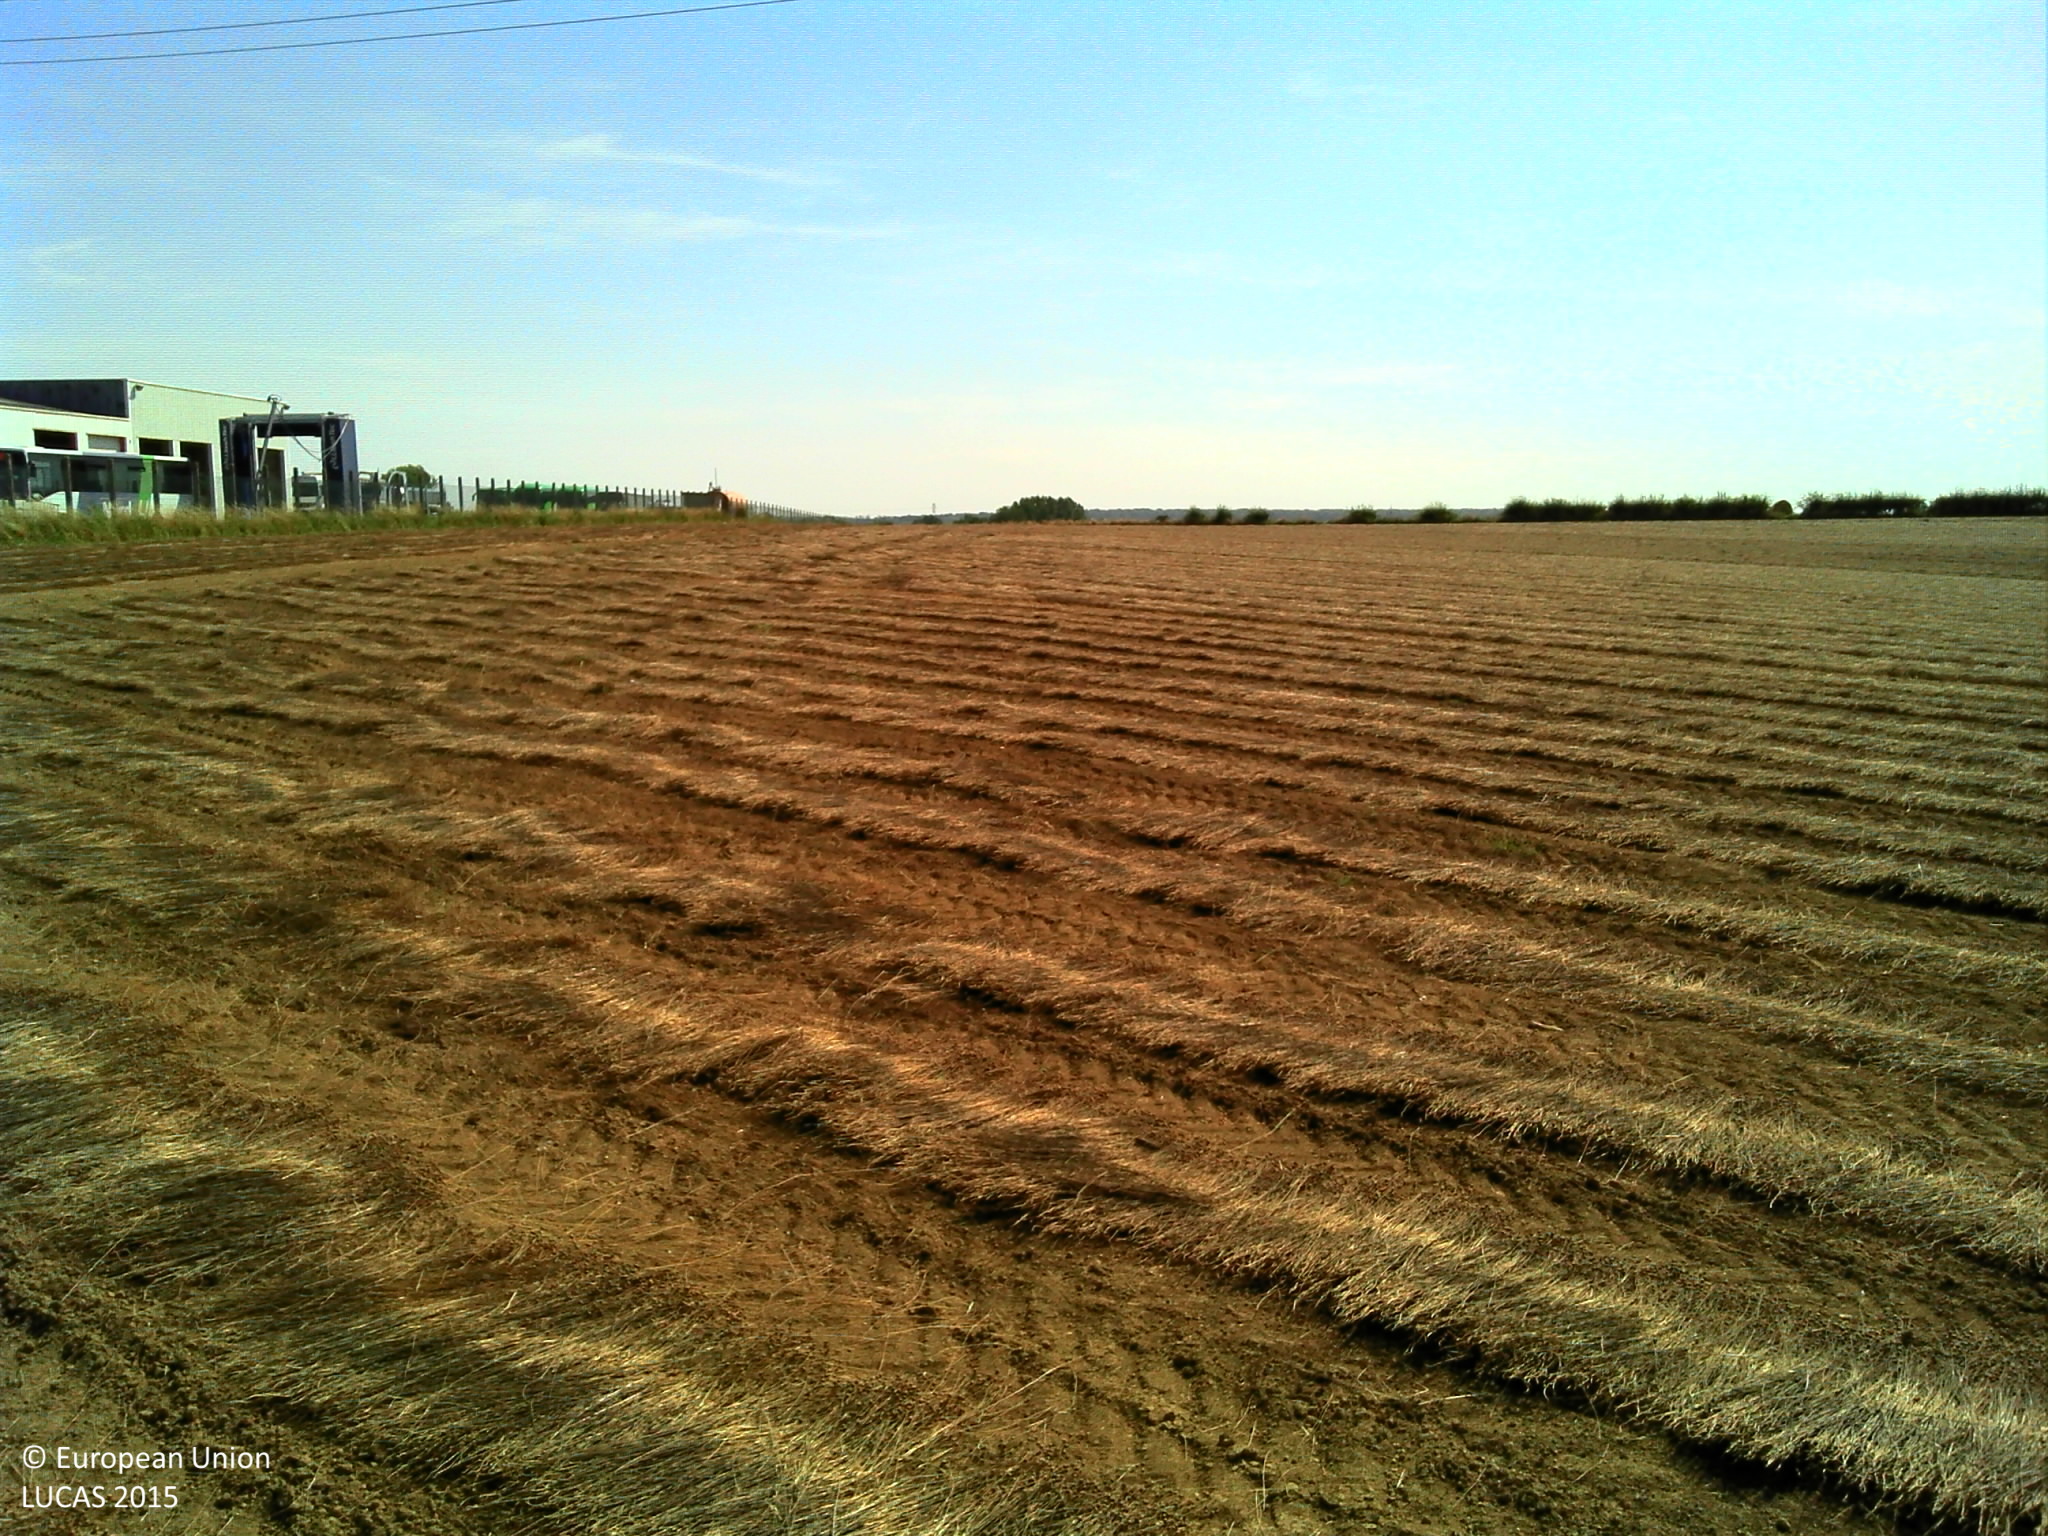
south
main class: Cropland
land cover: Other fibre and oleaginous crops
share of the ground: 10 - 25 %
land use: Agriculture (excluding fallow land and kitchen gardens)
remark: Harvested field
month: August
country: FR
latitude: 50.2400
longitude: 3.9510
